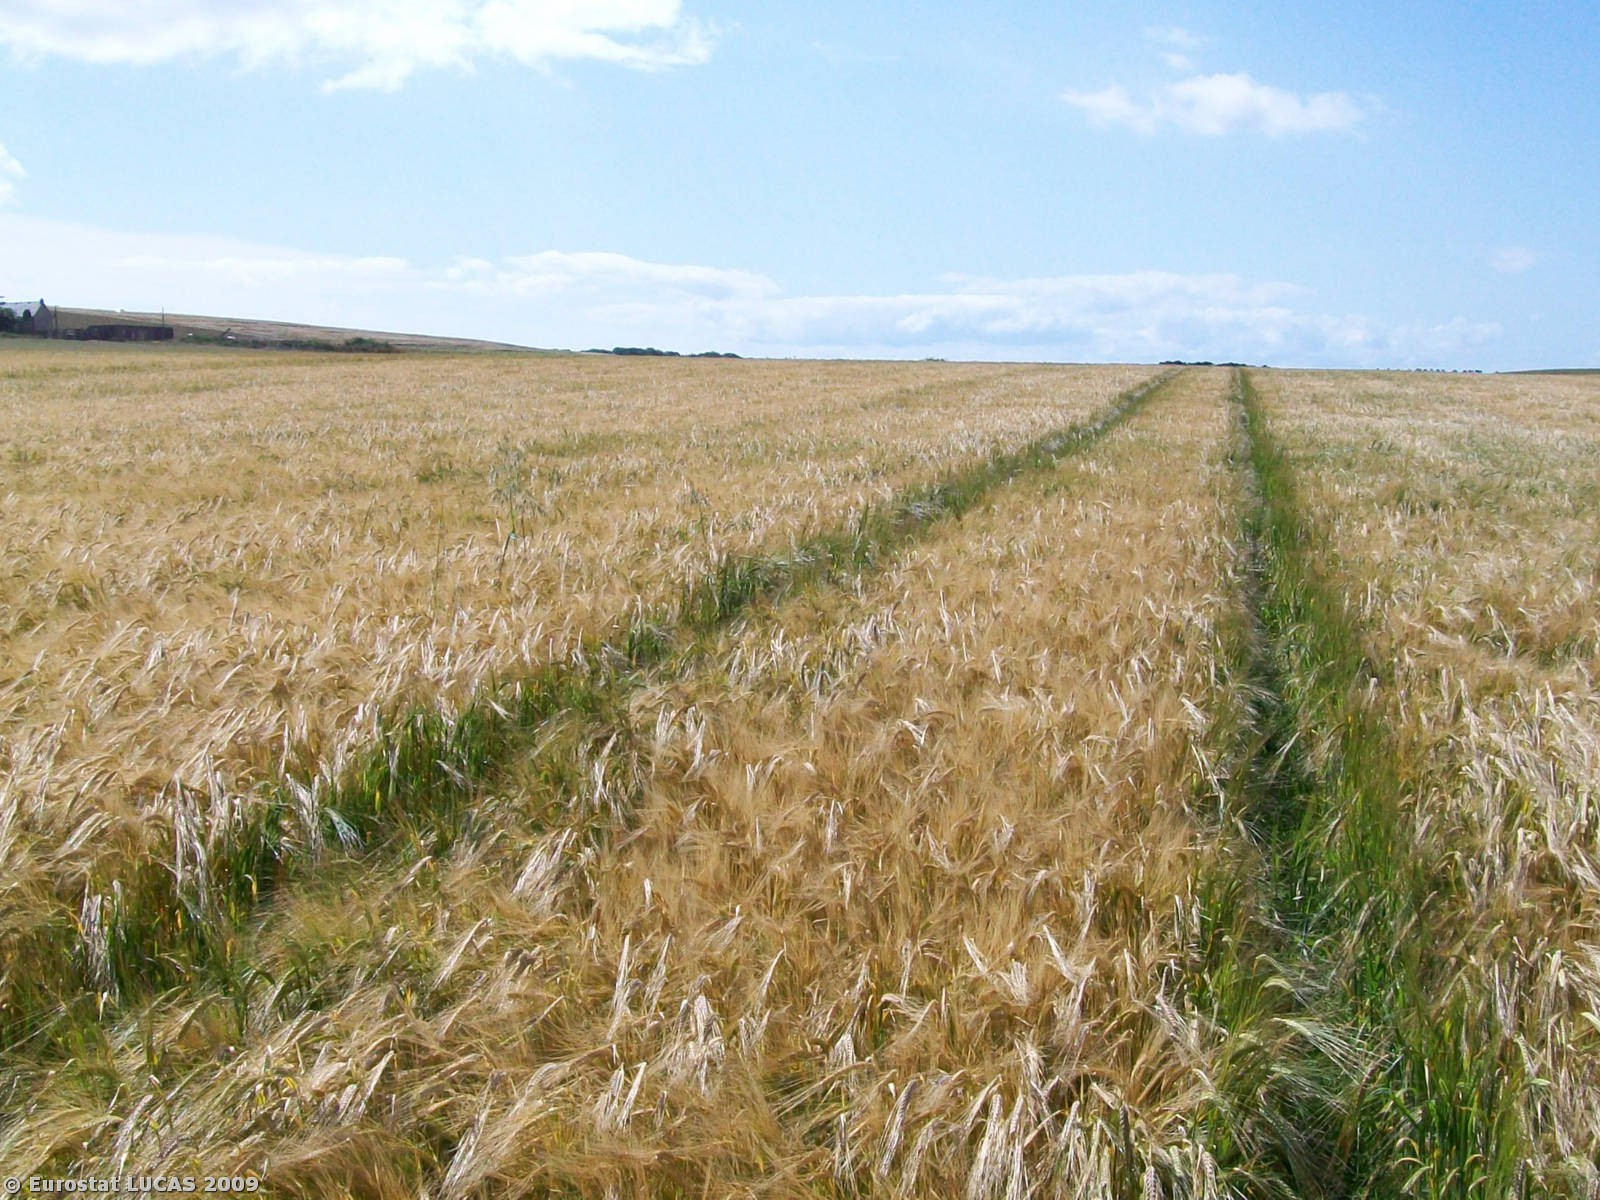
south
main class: Cropland
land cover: Barley
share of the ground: > 75 %
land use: Agriculture (excluding fallow land and kitchen gardens)
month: August
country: GB
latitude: 56.8438
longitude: -2.3655
